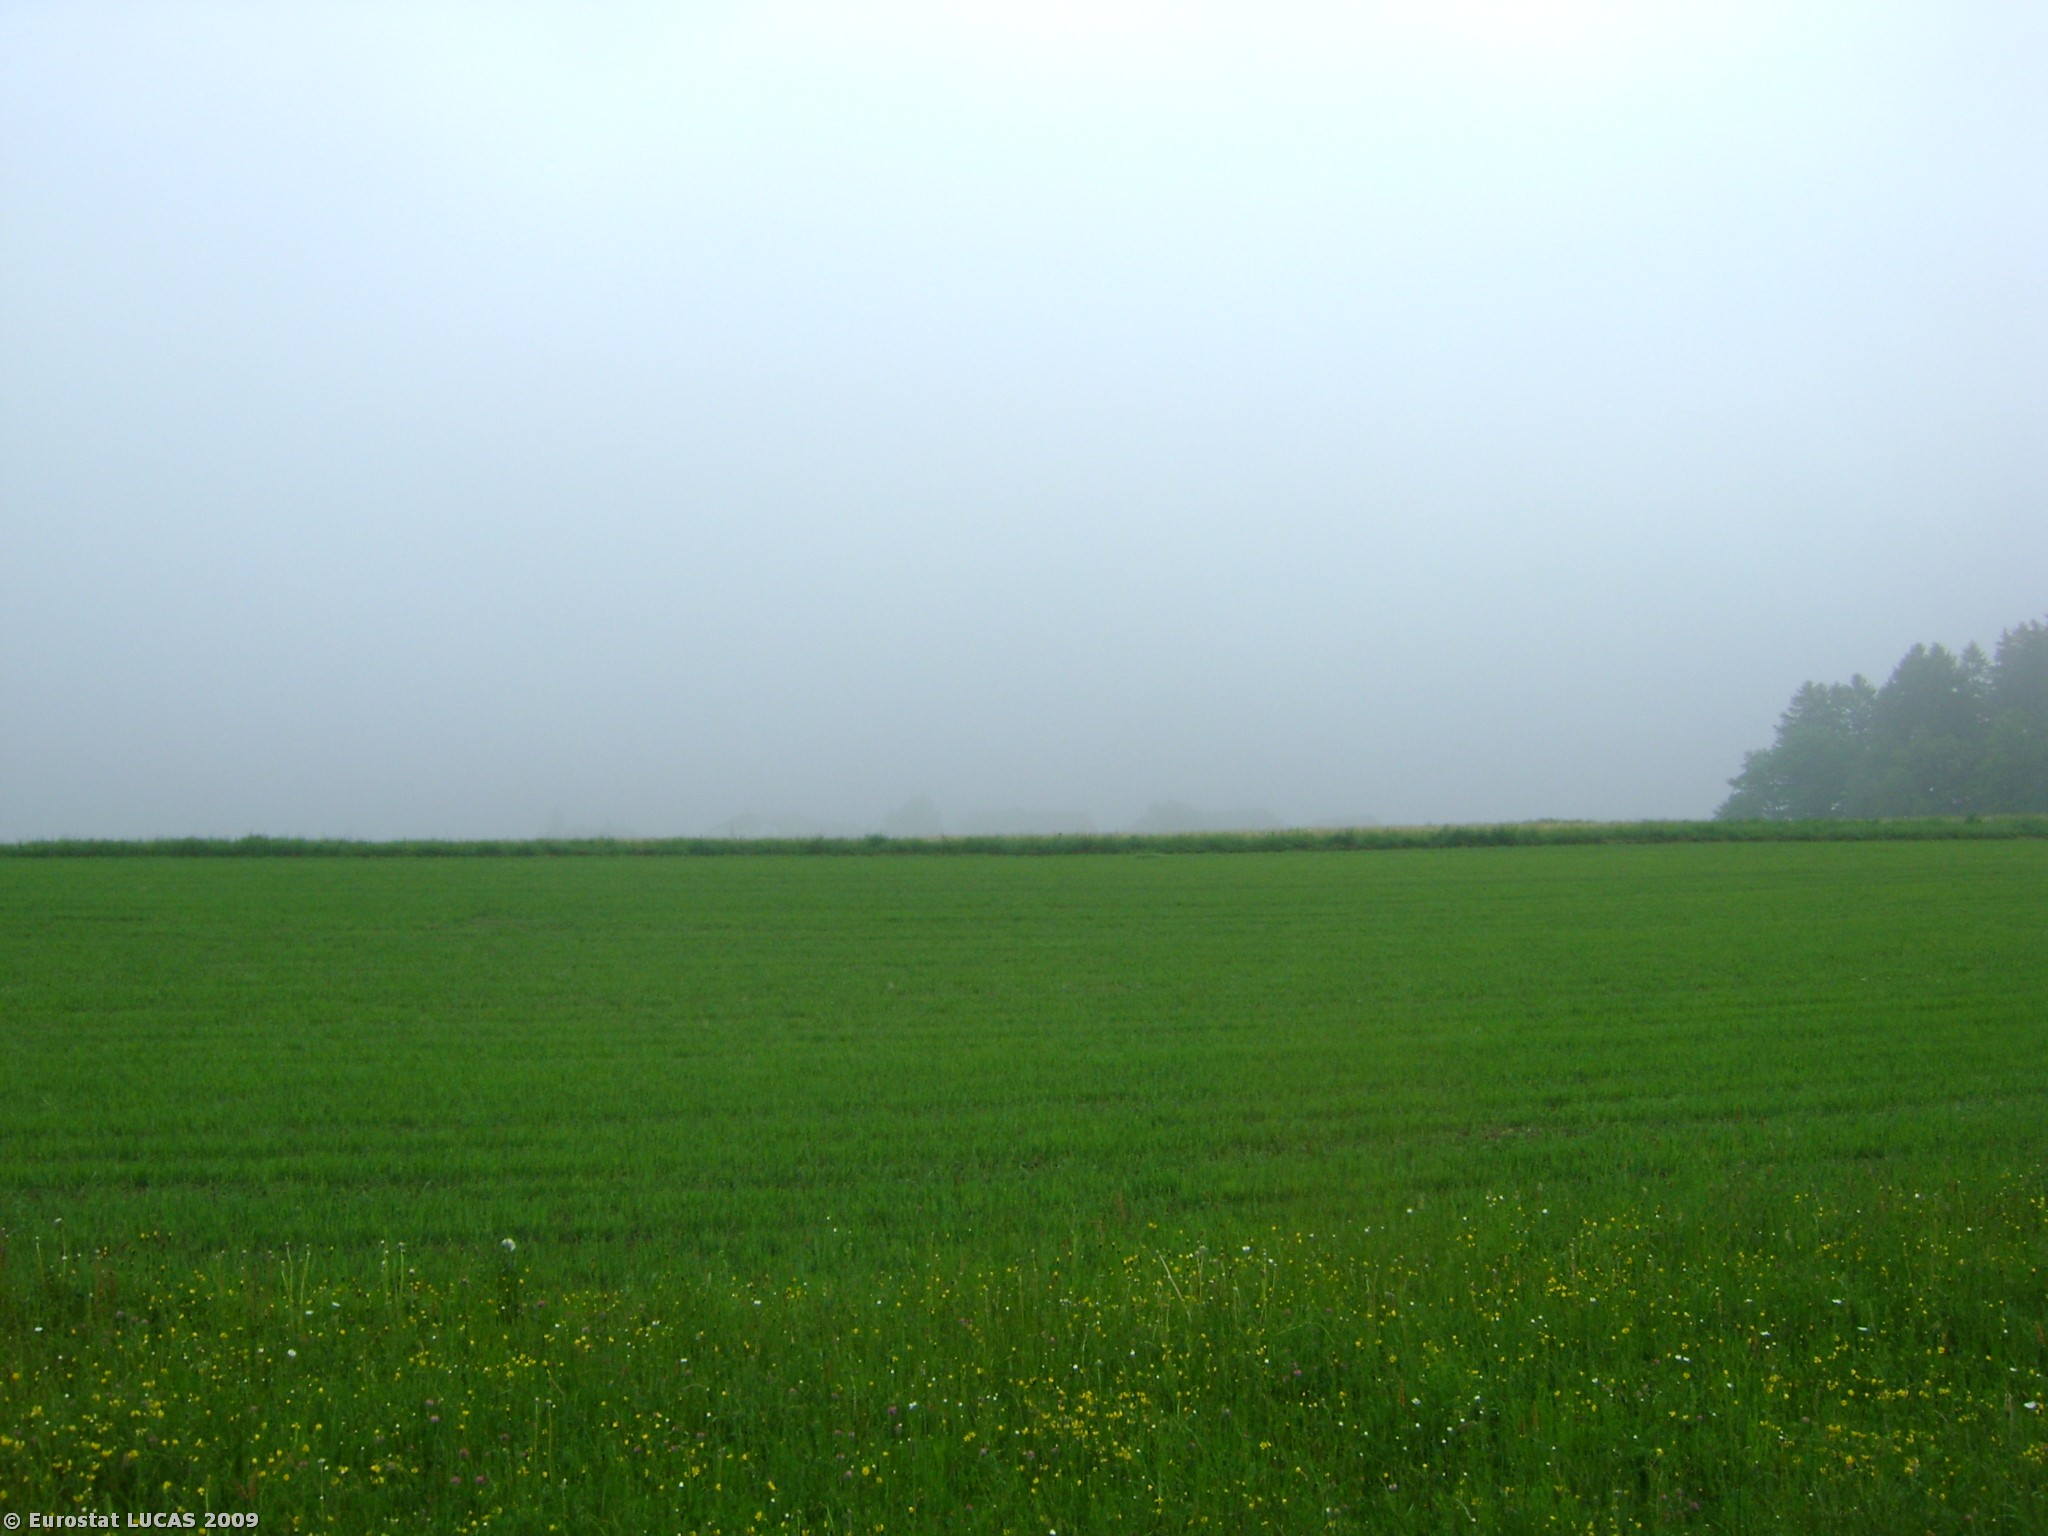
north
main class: Grassland
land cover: Grassland without tree/shrub cover
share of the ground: > 75 %
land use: Agriculture (excluding fallow land and kitchen gardens)
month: May
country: AT
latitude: 47.9594
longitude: 13.2531
